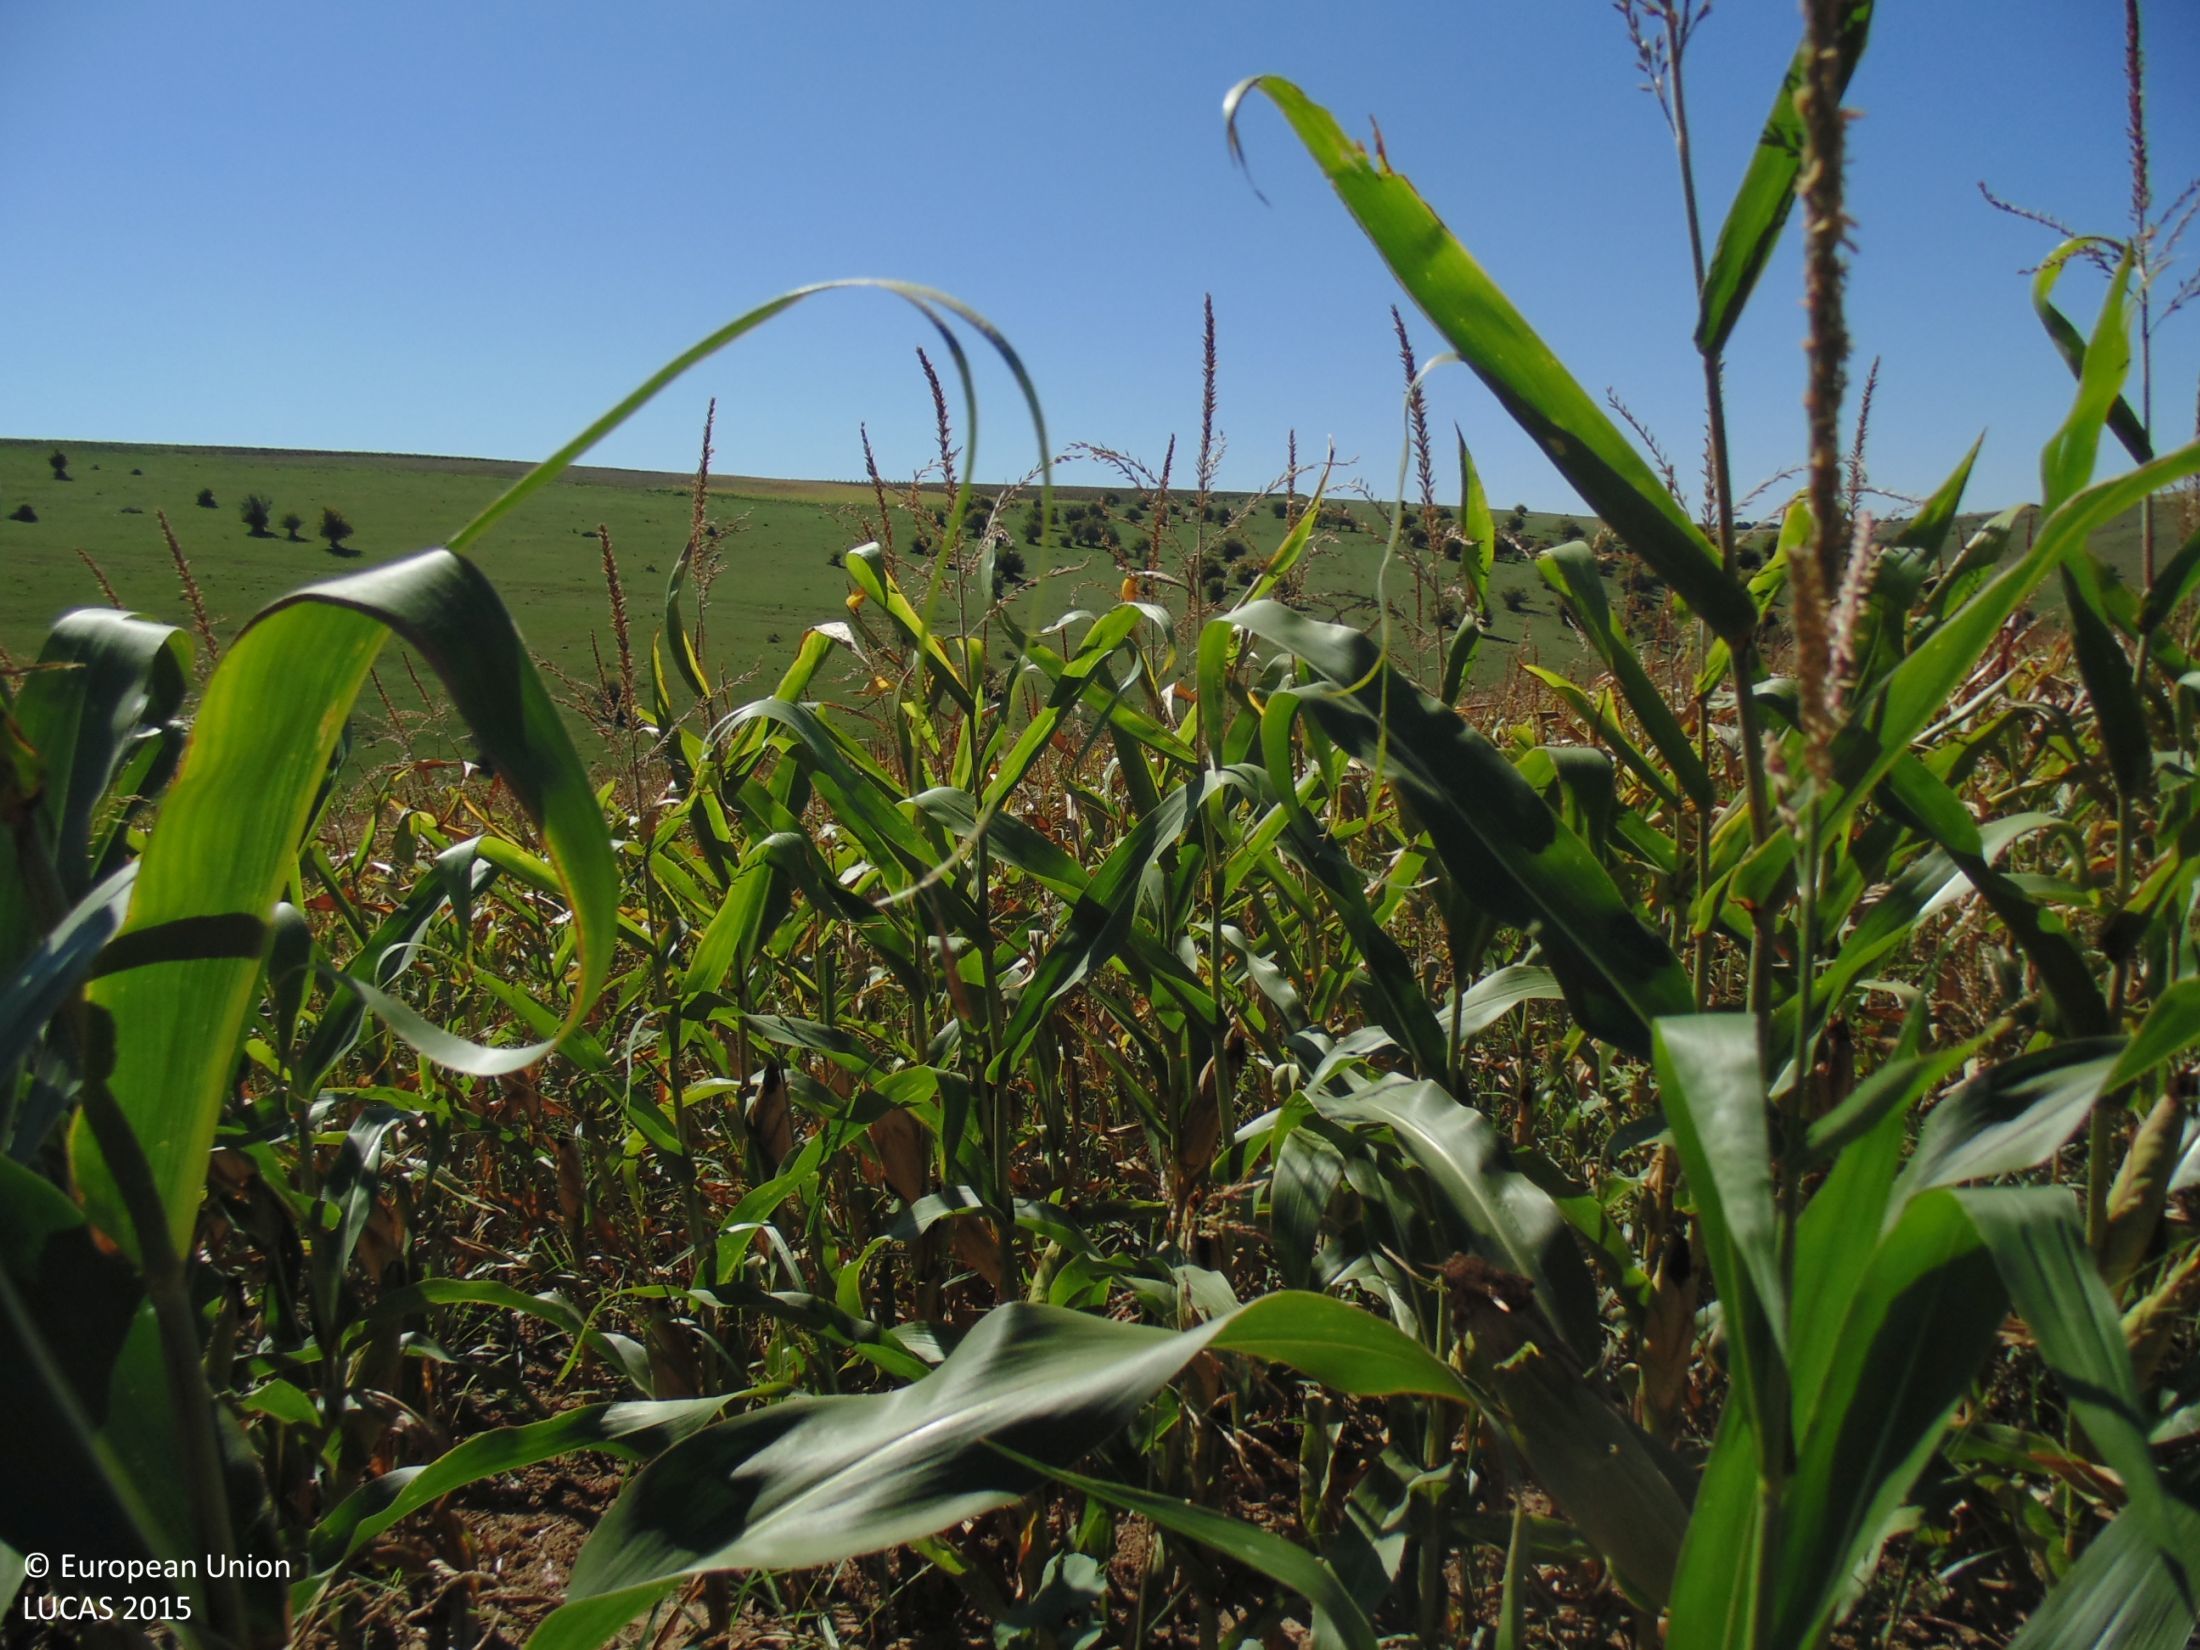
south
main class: Cropland
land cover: Maize
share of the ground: > 75 %
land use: Agriculture (excluding fallow land and kitchen gardens)
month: September
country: BG
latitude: 43.7930
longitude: 27.3682
